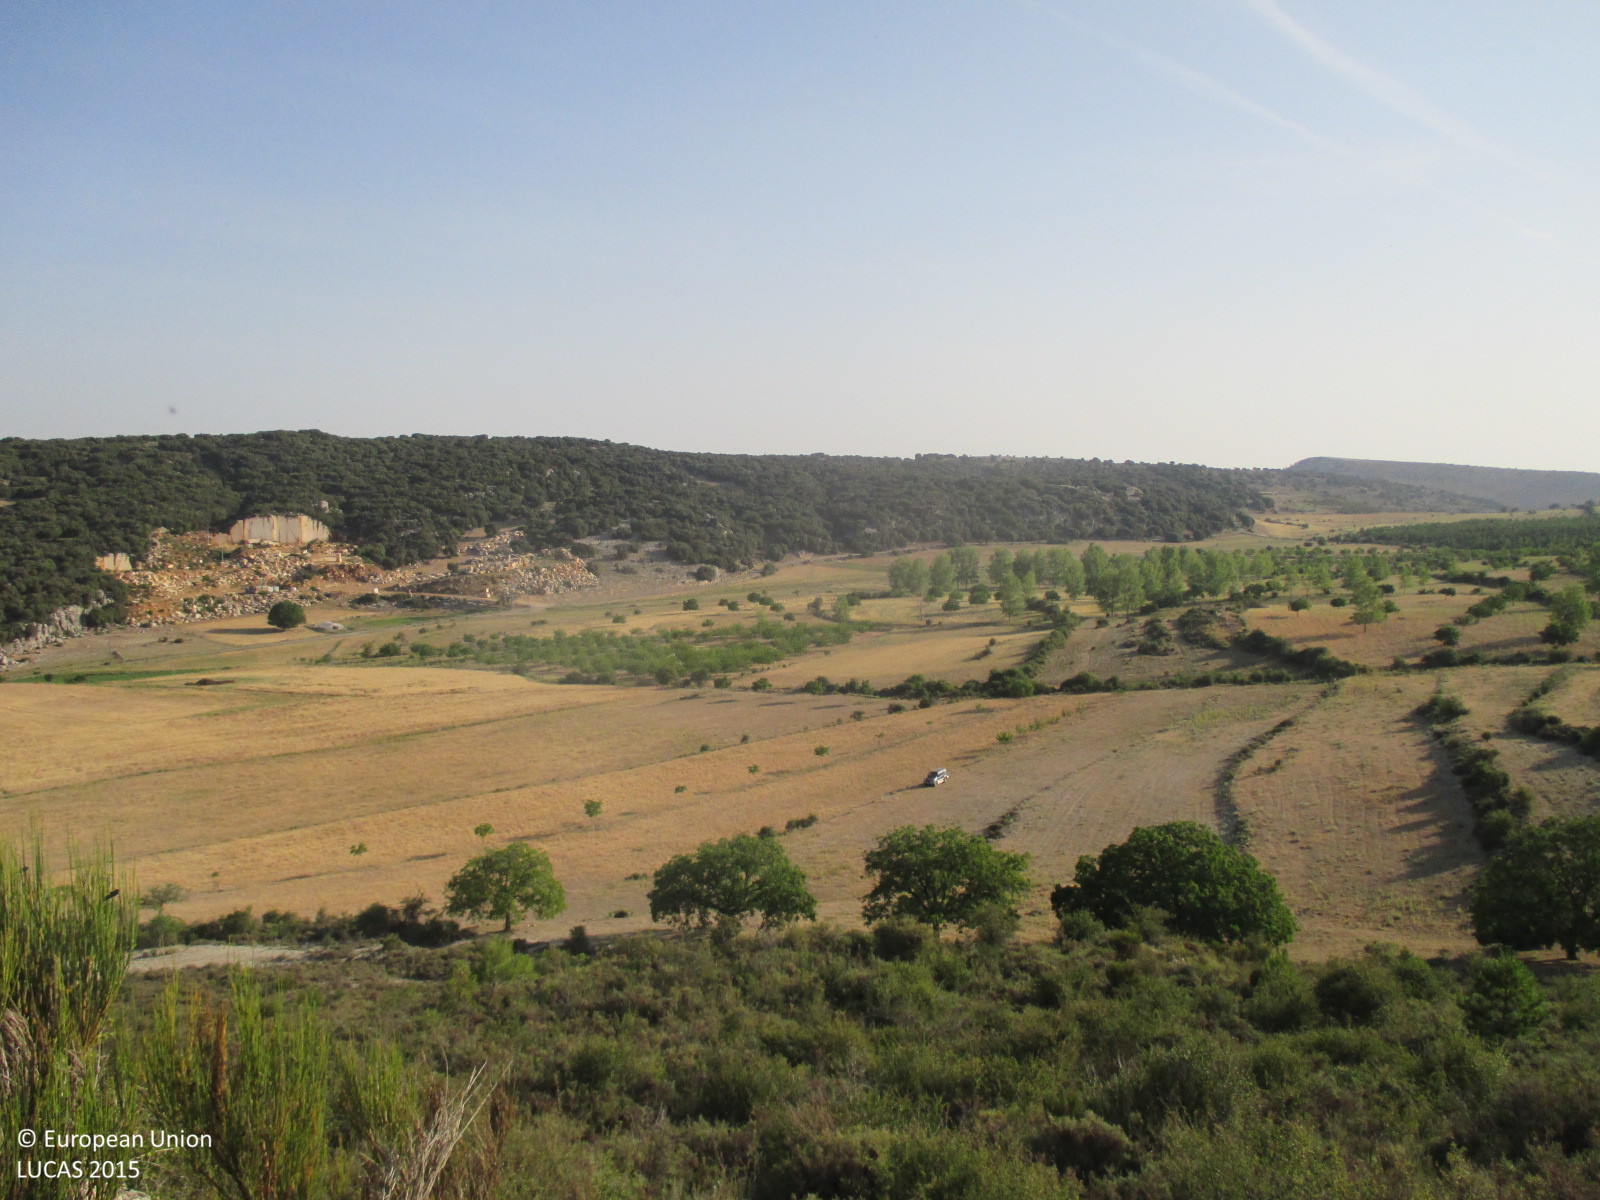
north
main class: Shrubland
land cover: Shrubland without tree cover
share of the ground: > 75 %
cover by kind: shrubs 90 %, herbaceous plants 10 %
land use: Semi-natural and natural areas not in use
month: July
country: ES
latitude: 38.0856
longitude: -2.4087
